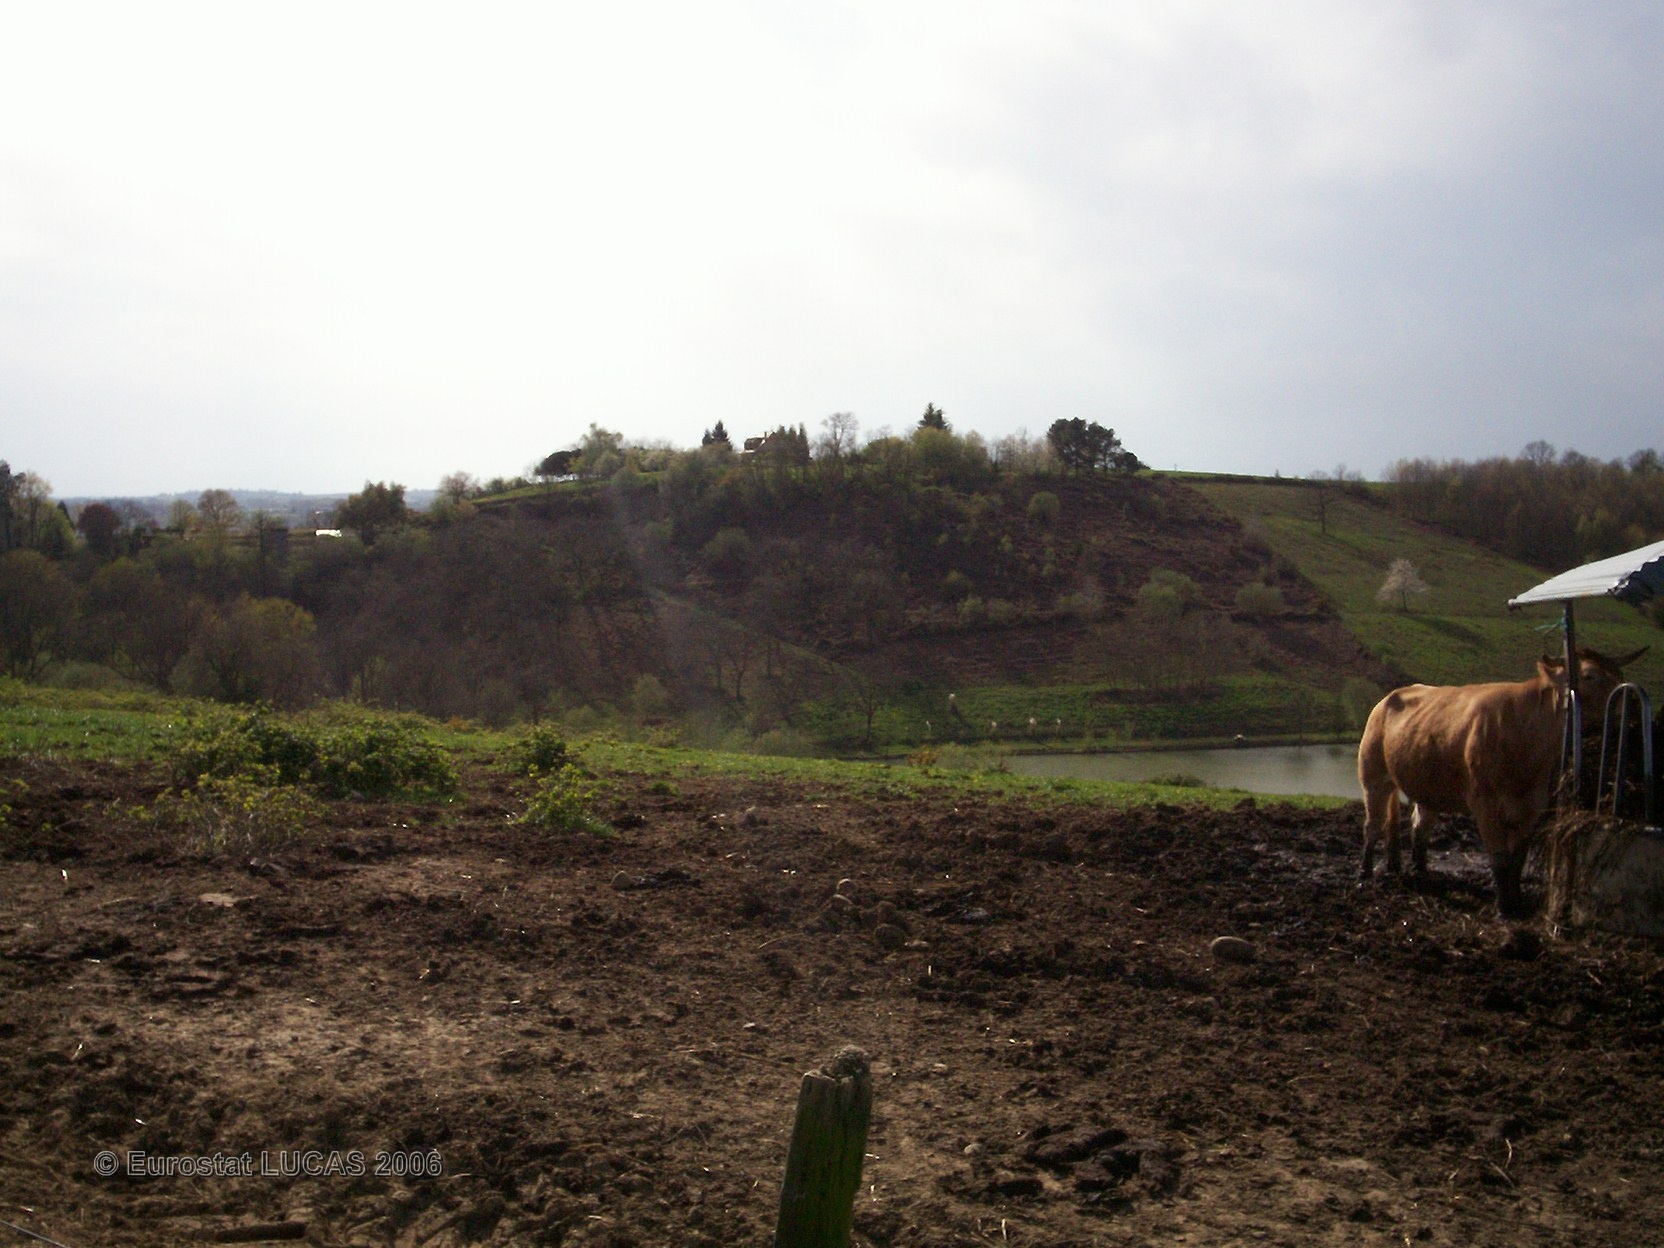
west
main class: Grassland
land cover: Grassland without tree/shrub cover
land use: Agriculture (excluding fallow land and kitchen gardens)
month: April
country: FR
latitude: 43.5361
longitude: -0.2165
